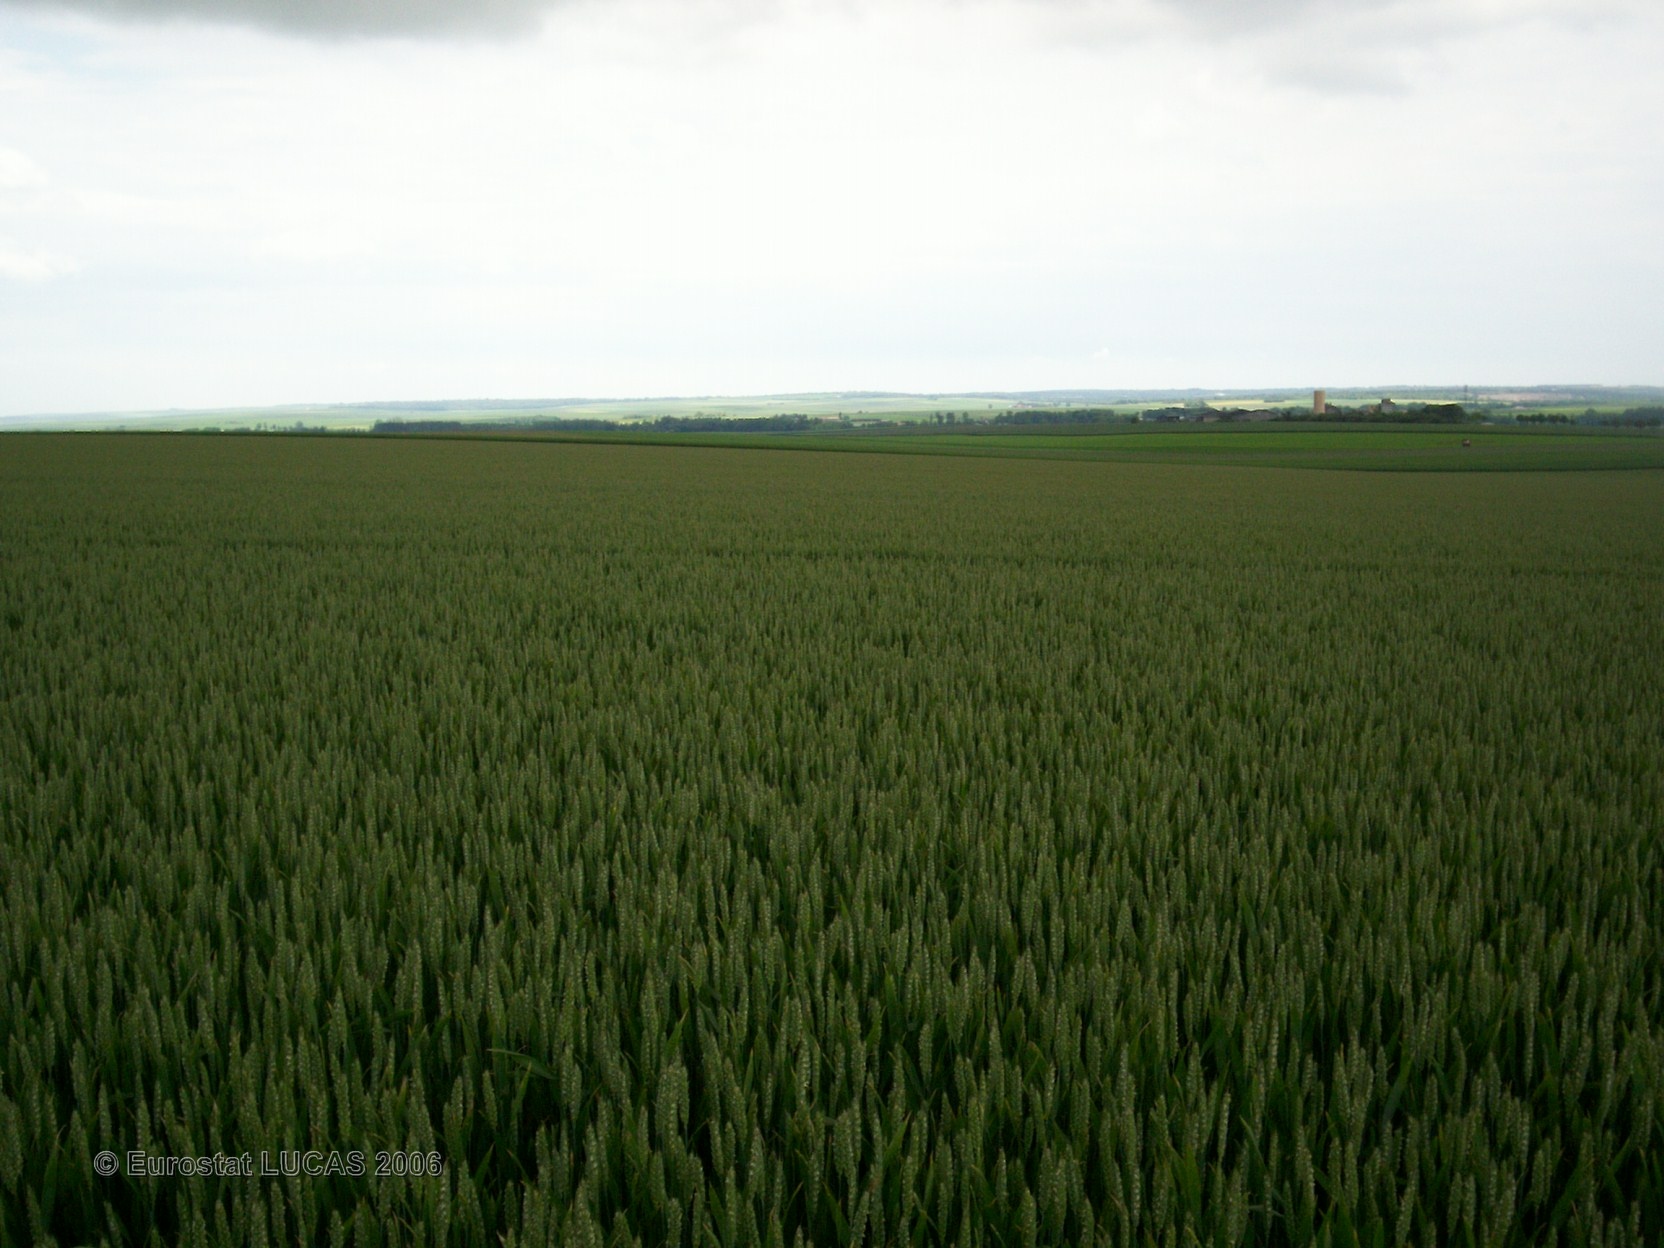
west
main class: Cropland
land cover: Barley
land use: Agriculture (excluding fallow land and kitchen gardens)
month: June
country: FR
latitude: 48.6068
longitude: 4.4500
